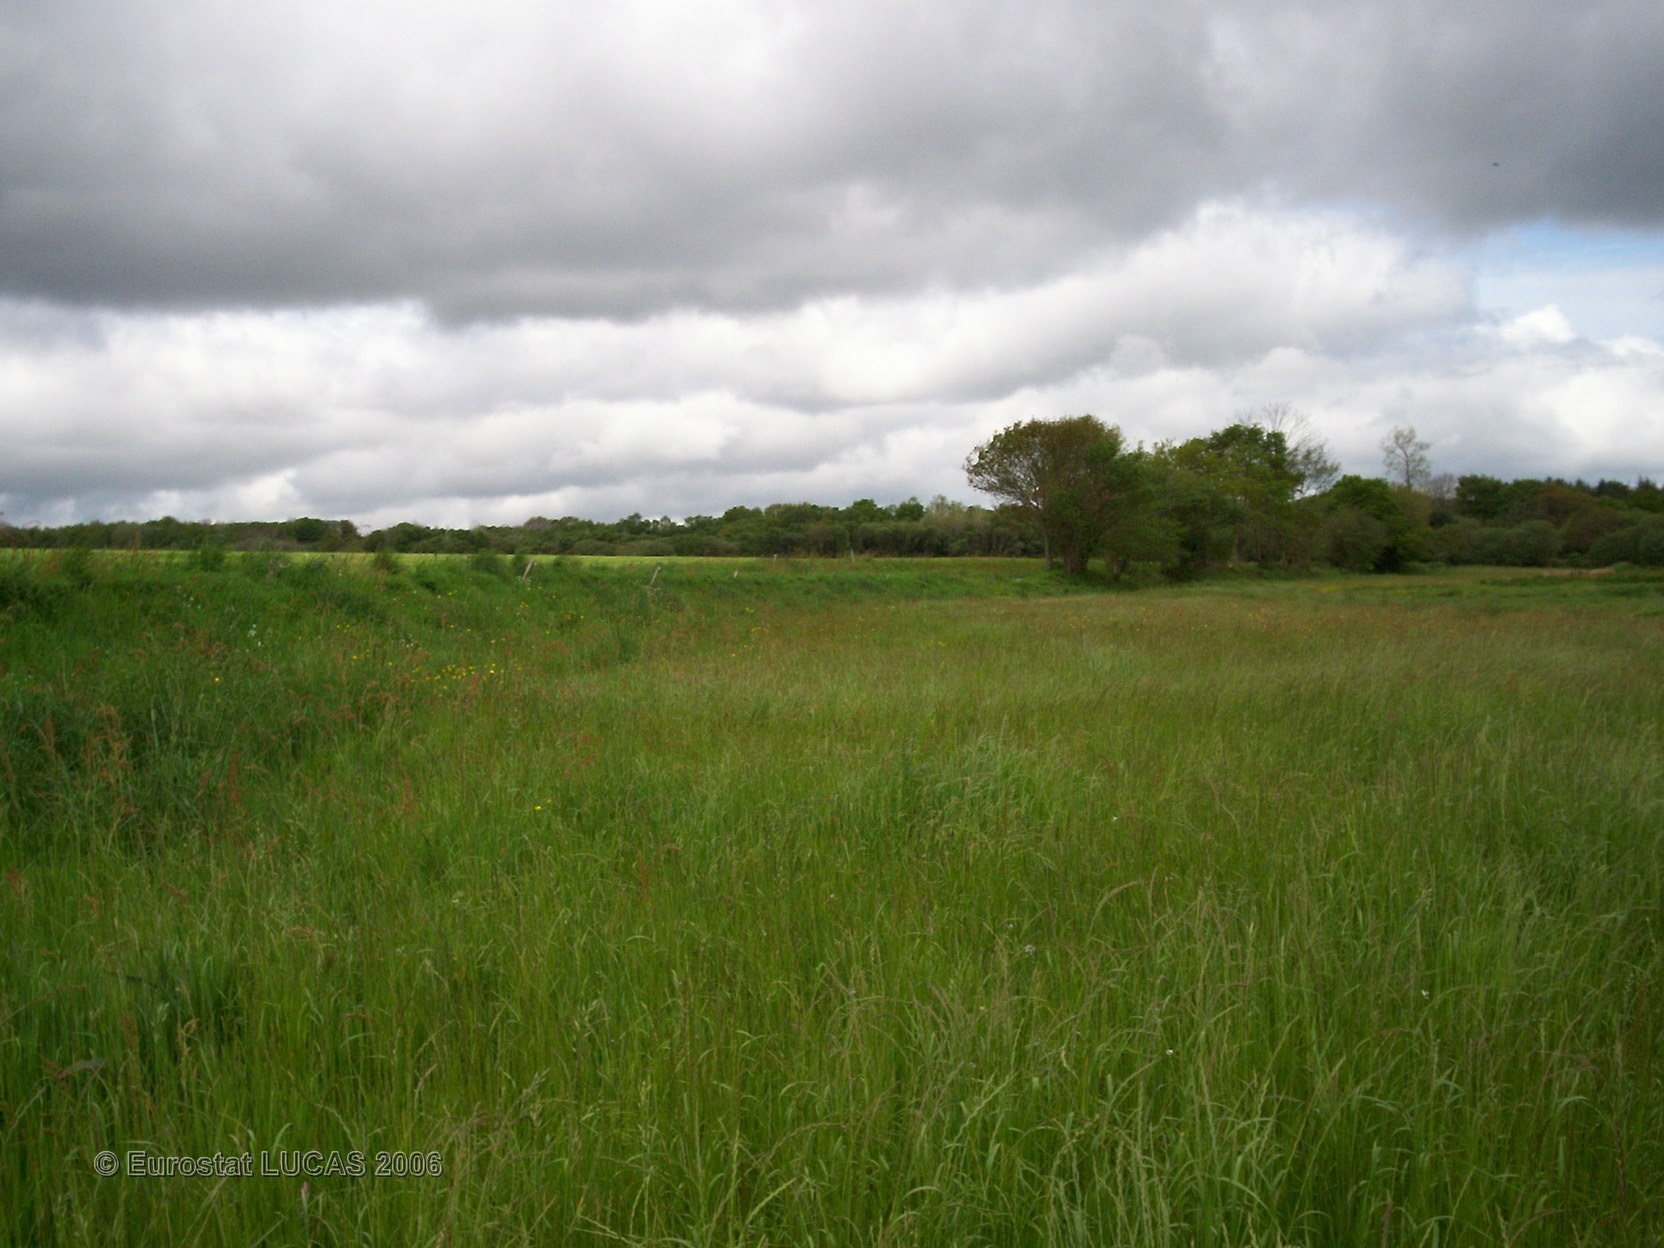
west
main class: Grassland
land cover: Grassland without tree/shrub cover
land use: Agriculture (excluding fallow land and kitchen gardens)
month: May
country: FR
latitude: 48.5816
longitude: -3.7341
